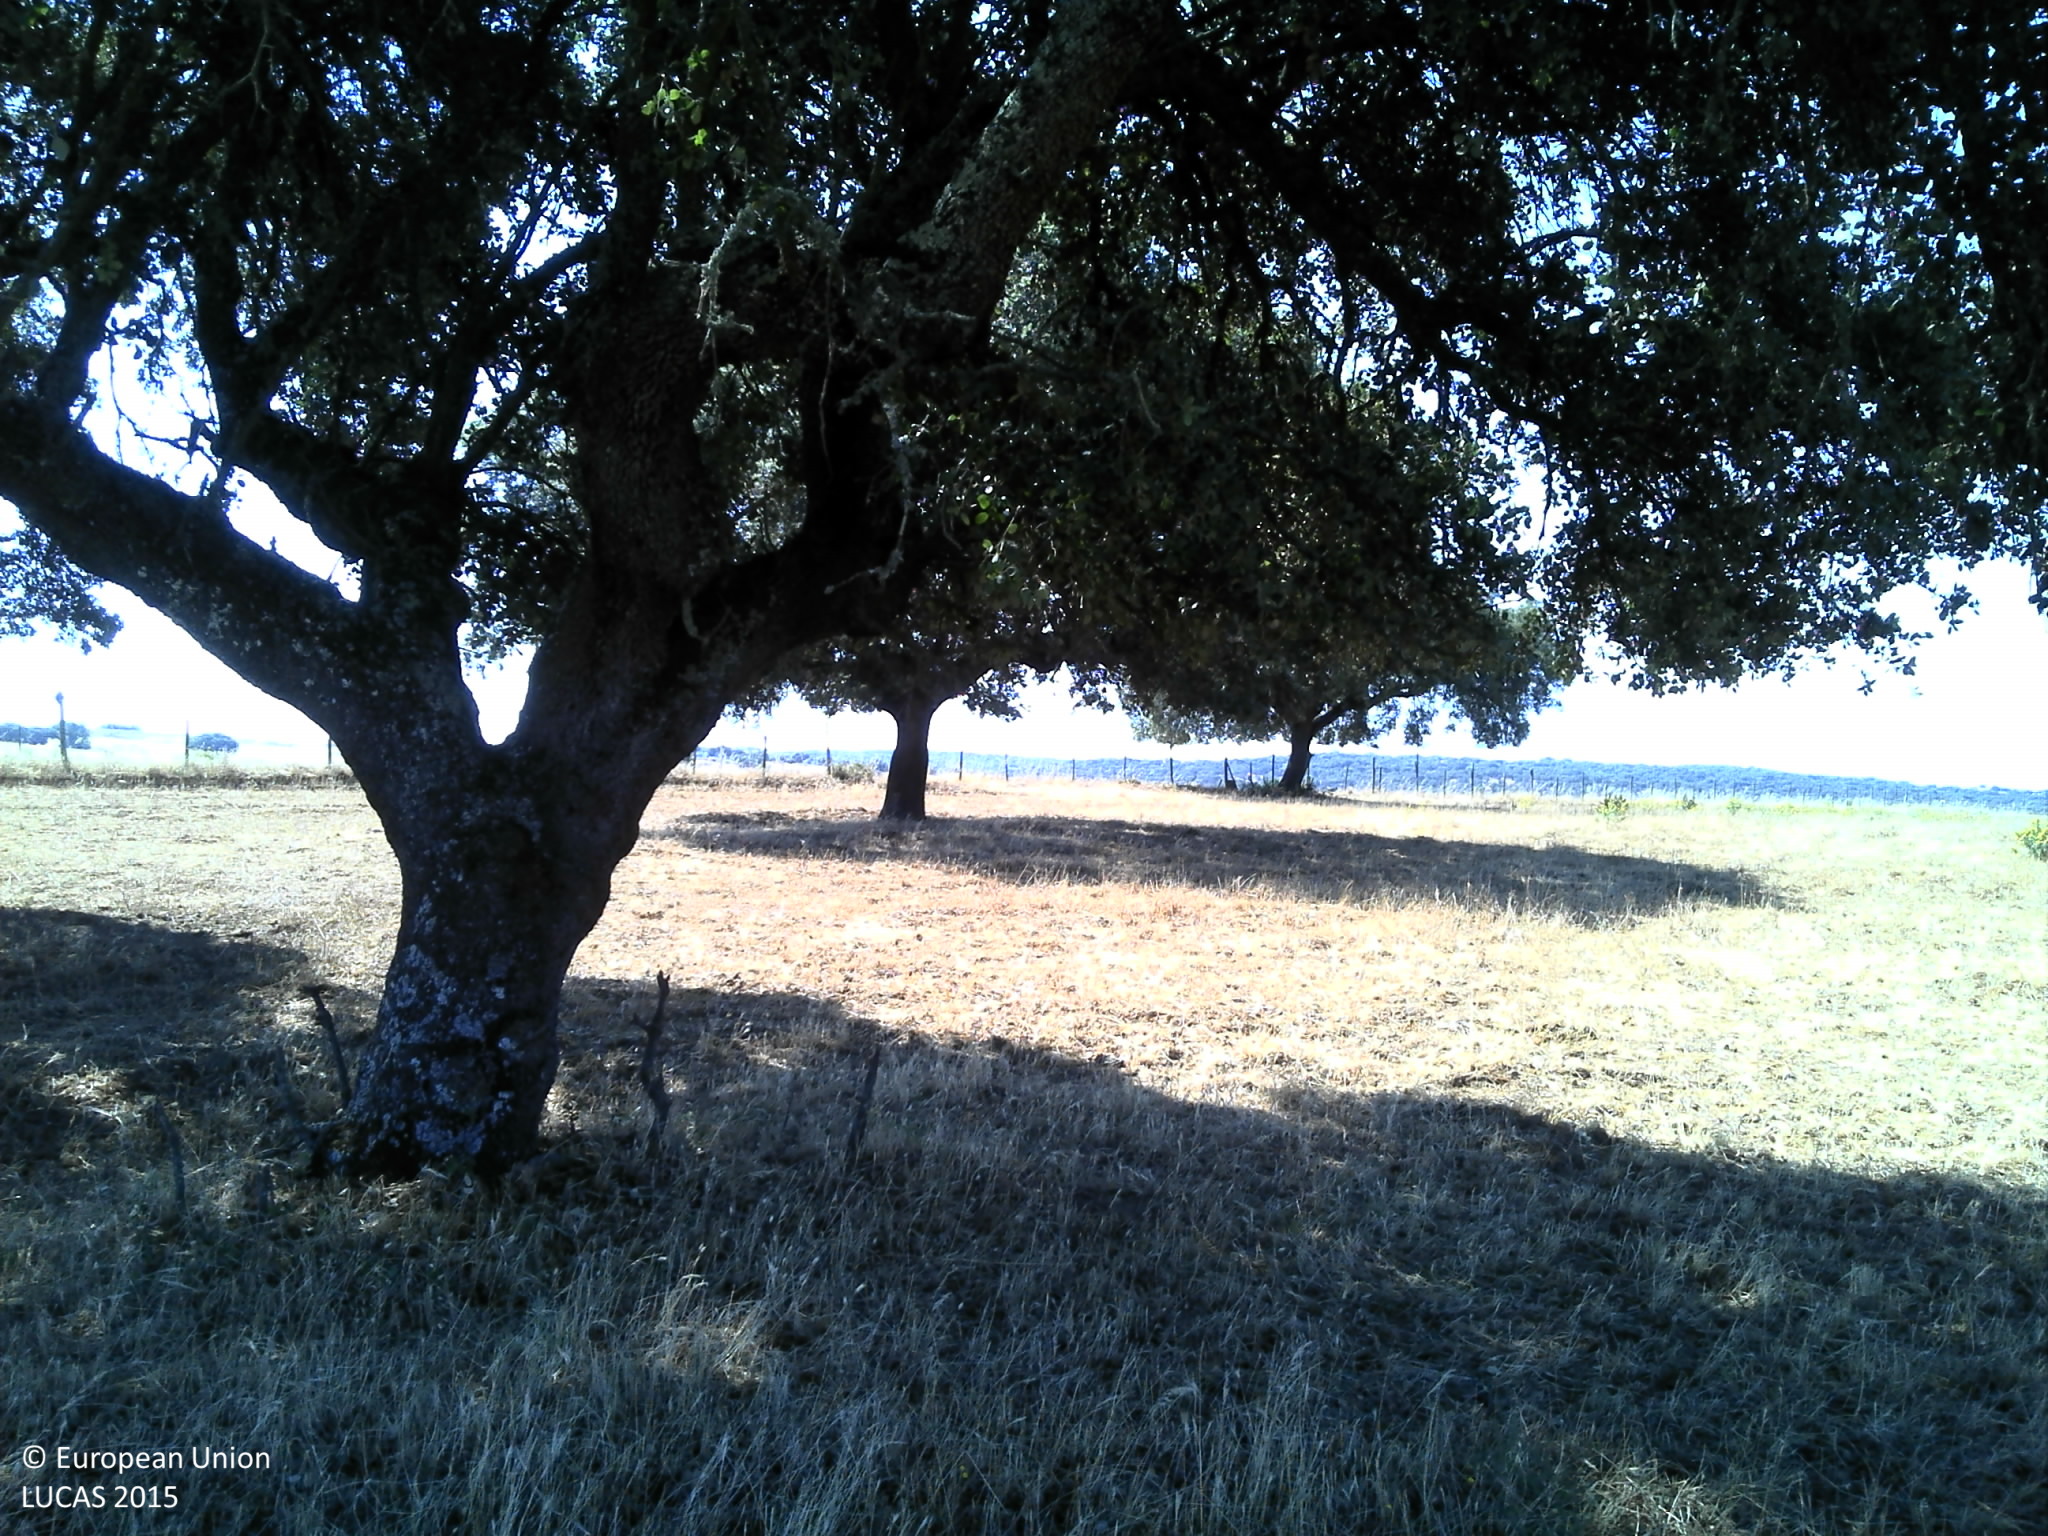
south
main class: Woodland
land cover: Broadleaved woodland
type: broadleaved evergreen forest
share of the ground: 10 - 25 %
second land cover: Grassland without tree/shrub cover
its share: 10 - 25 %
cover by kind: unconsolidated bare surface 70 %, broadleaved forest trees 15 %, herbaceous plants 15 %
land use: Forestry
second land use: Agriculture (excluding fallow land and kitchen gardens)
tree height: > 5 m
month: June
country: PT
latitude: 38.4544
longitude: -8.1134
